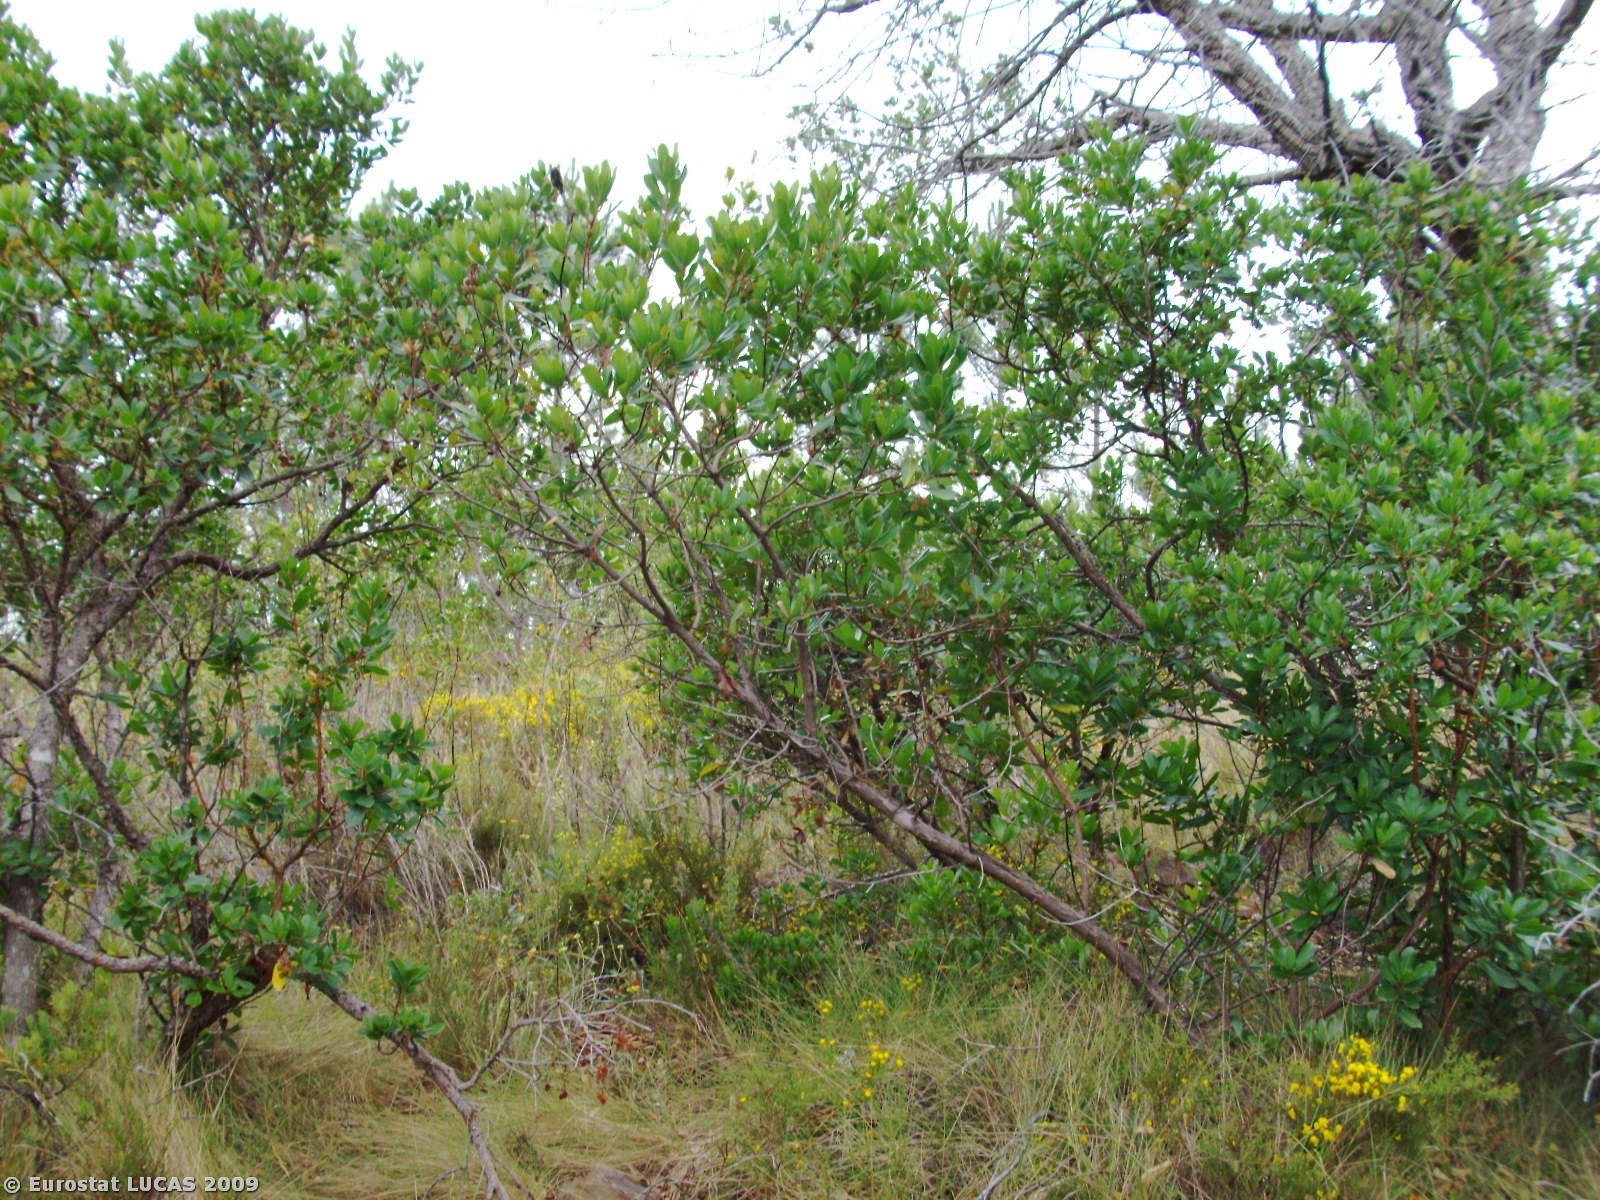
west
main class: Woodland
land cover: Coniferous woodland
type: coniferous forest of the mediterranean region
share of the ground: 10 - 25 %
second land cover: Shrubland with sparse tree cover
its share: 50 - 75 %
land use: Forestry
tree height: > 5 m
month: June
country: PT
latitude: 37.1829
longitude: -8.8336
